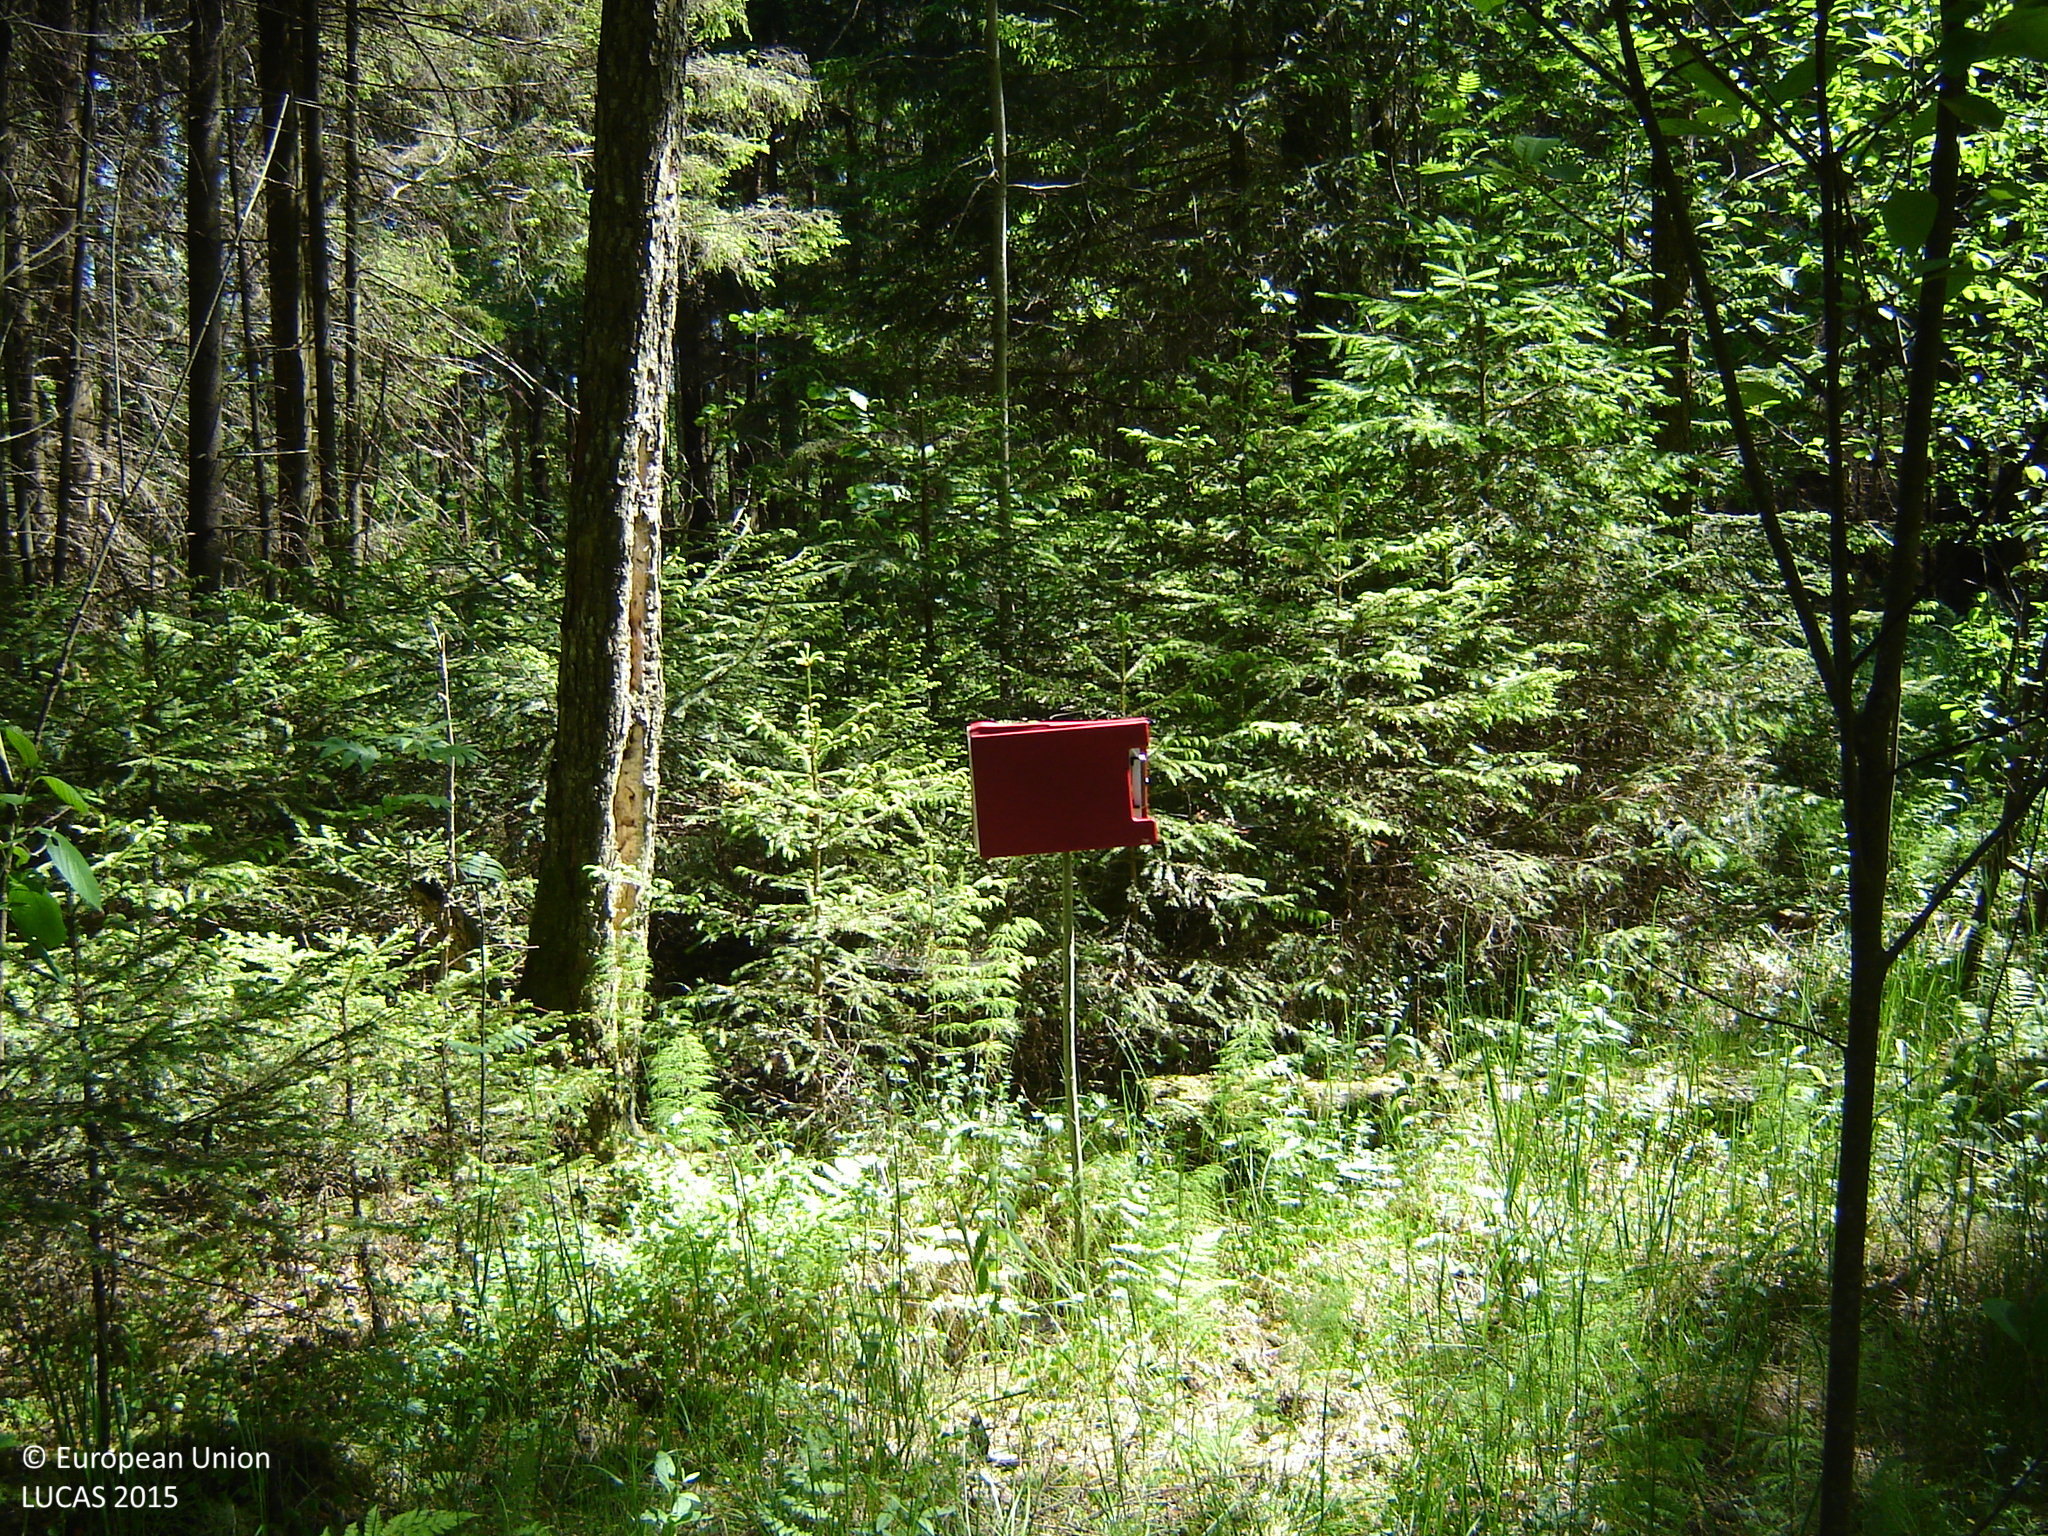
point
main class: Woodland
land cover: Spruce dominated coniferous woodland
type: hemiboreal forest and nemoral coniferous forest and mixed broadleaved-coniferous forest
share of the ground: > 75 %
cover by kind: coniferous forest trees 80 %, broadleaved forest trees 10 %, herbaceous plants 10 %
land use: Forestry
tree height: > 5 m
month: June
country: LT
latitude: 55.5932
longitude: 25.1422
